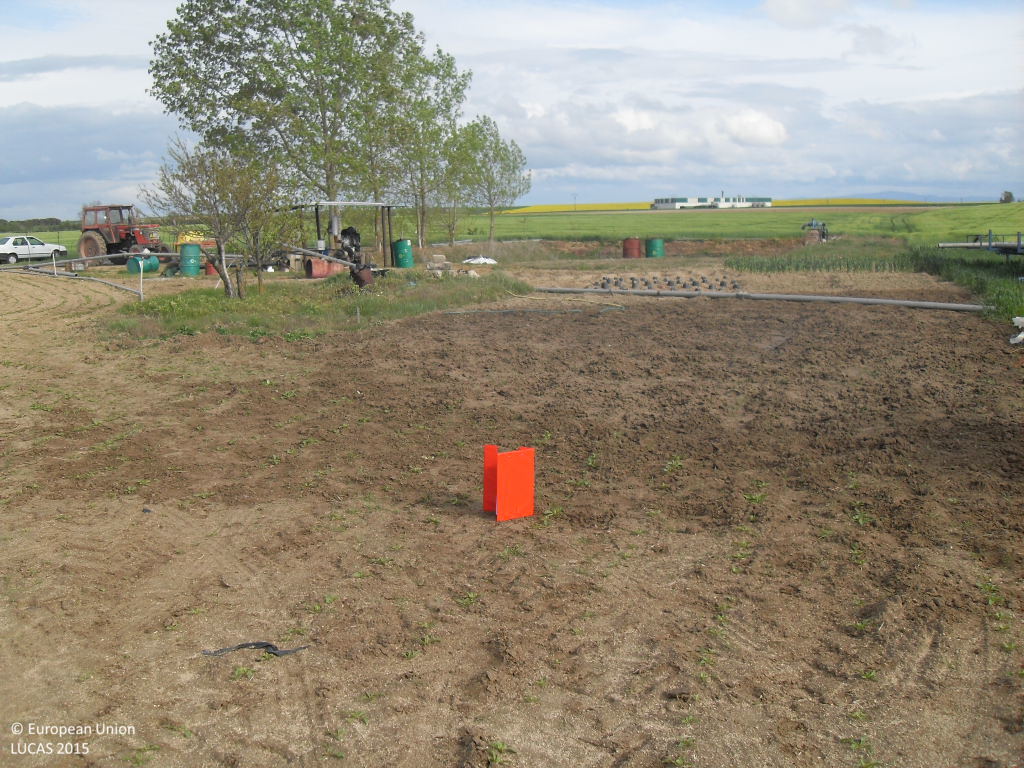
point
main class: Cropland
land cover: Sugar beet
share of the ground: > 75 %
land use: Agriculture (excluding fallow land and kitchen gardens)
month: April
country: ES
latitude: 40.9641
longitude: -5.2184
